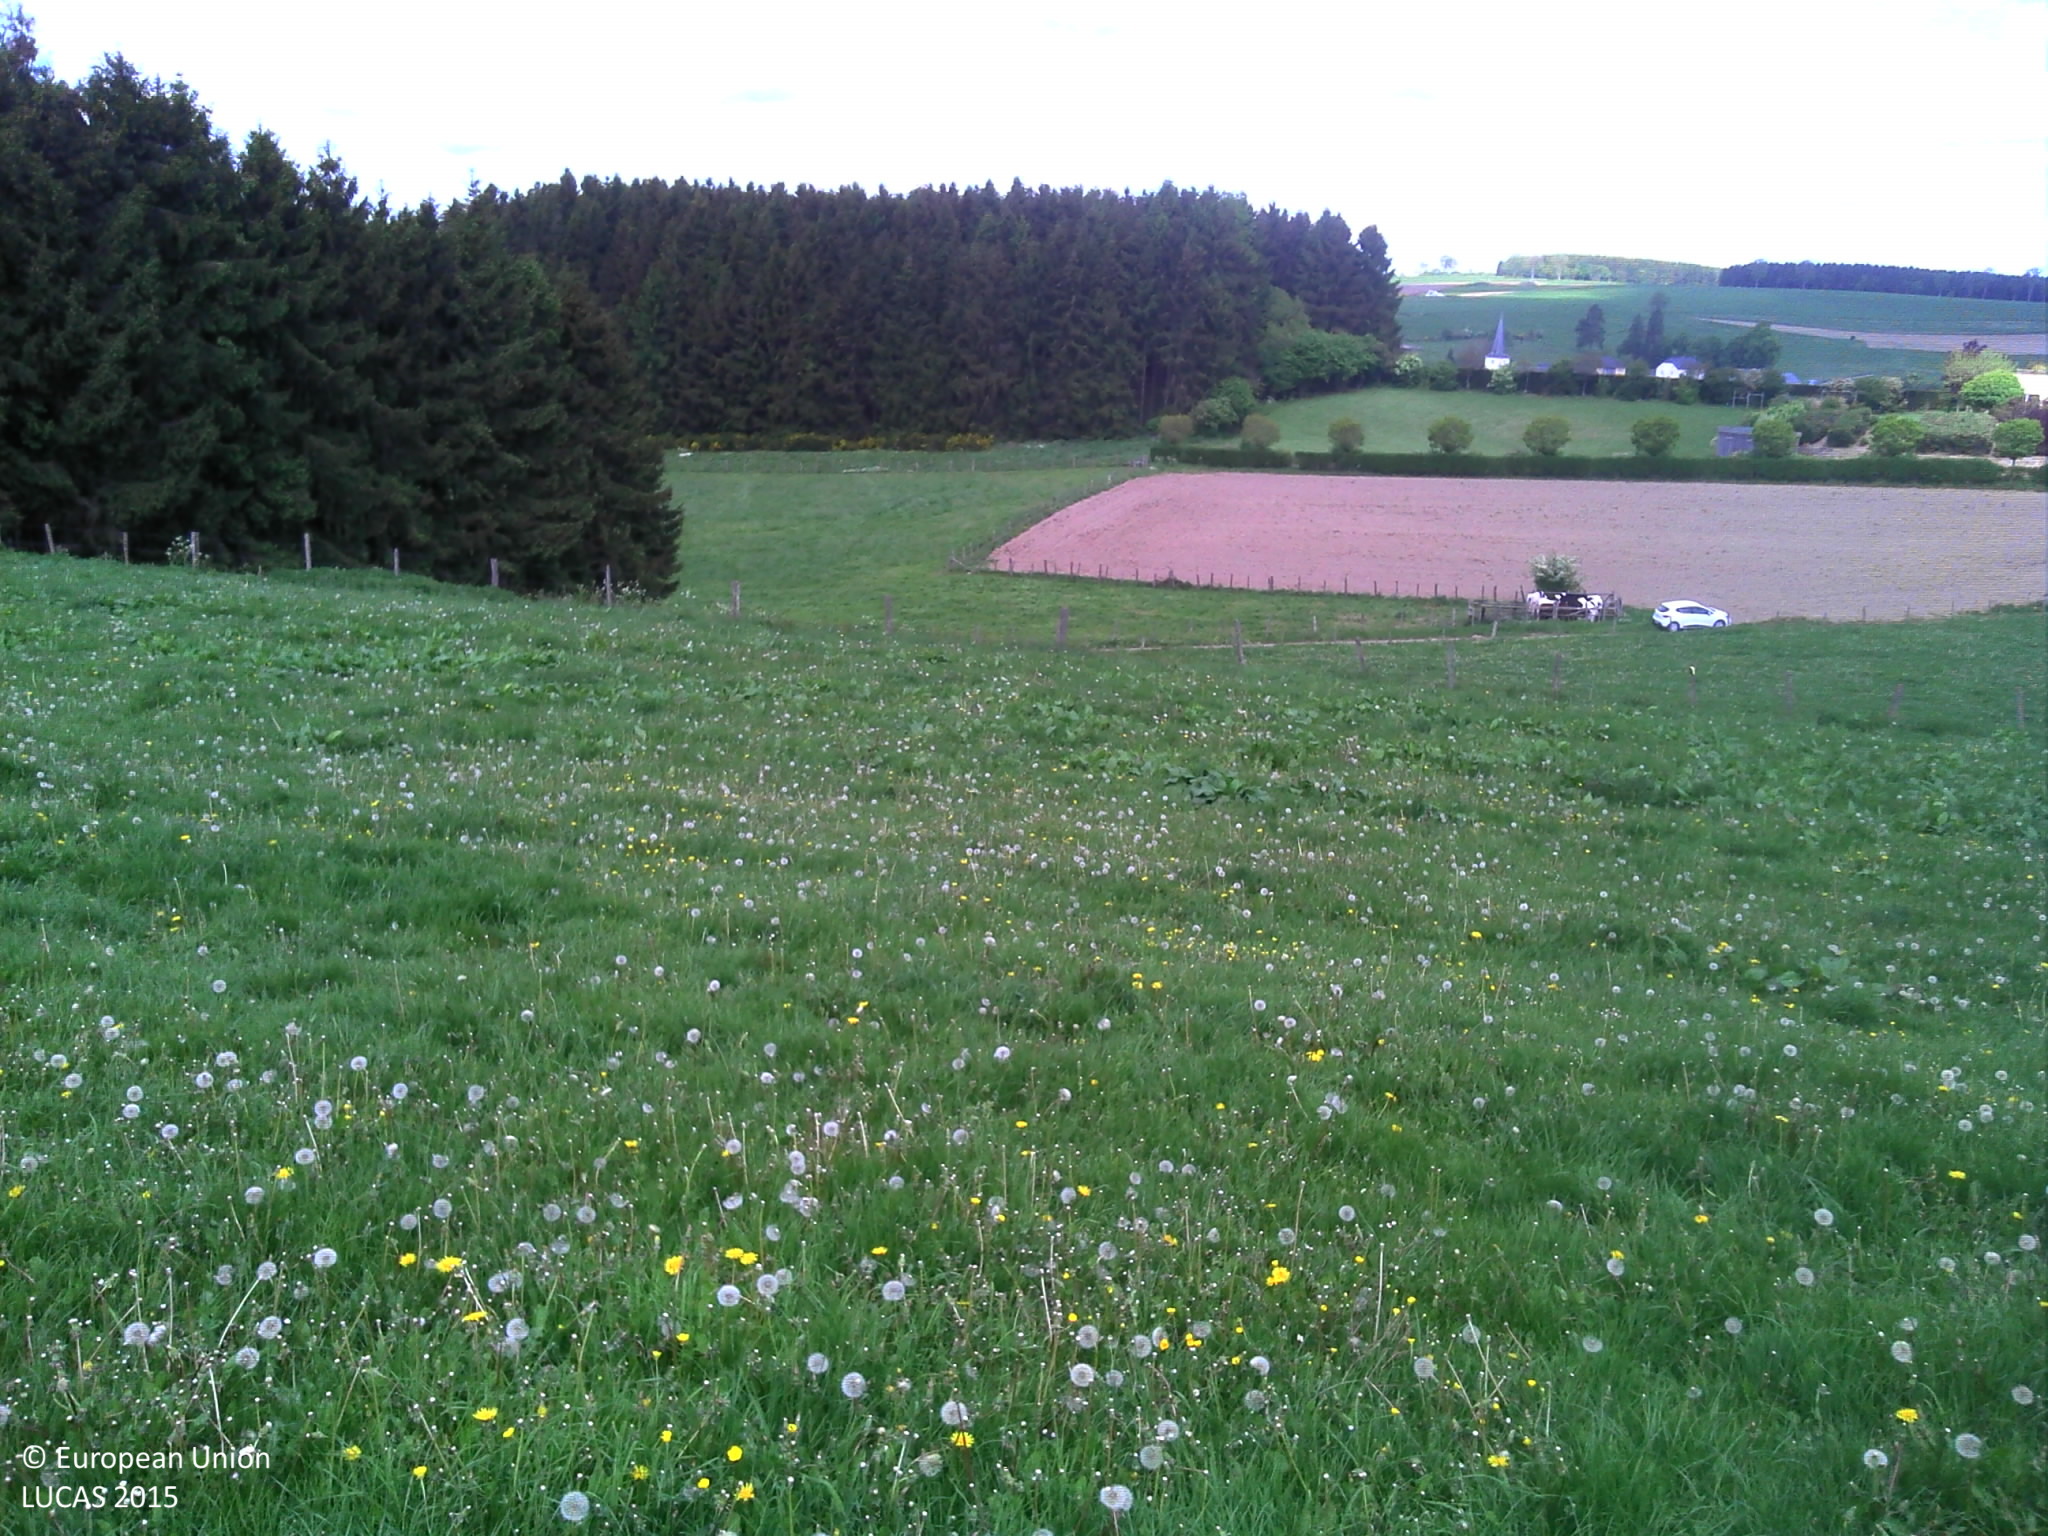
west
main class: Grassland
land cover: Grassland without tree/shrub cover
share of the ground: > 75 %
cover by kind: herbaceous plants 100 %
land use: Agriculture (excluding fallow land and kitchen gardens)
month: May
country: LU
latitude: 50.0588
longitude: 5.9622
